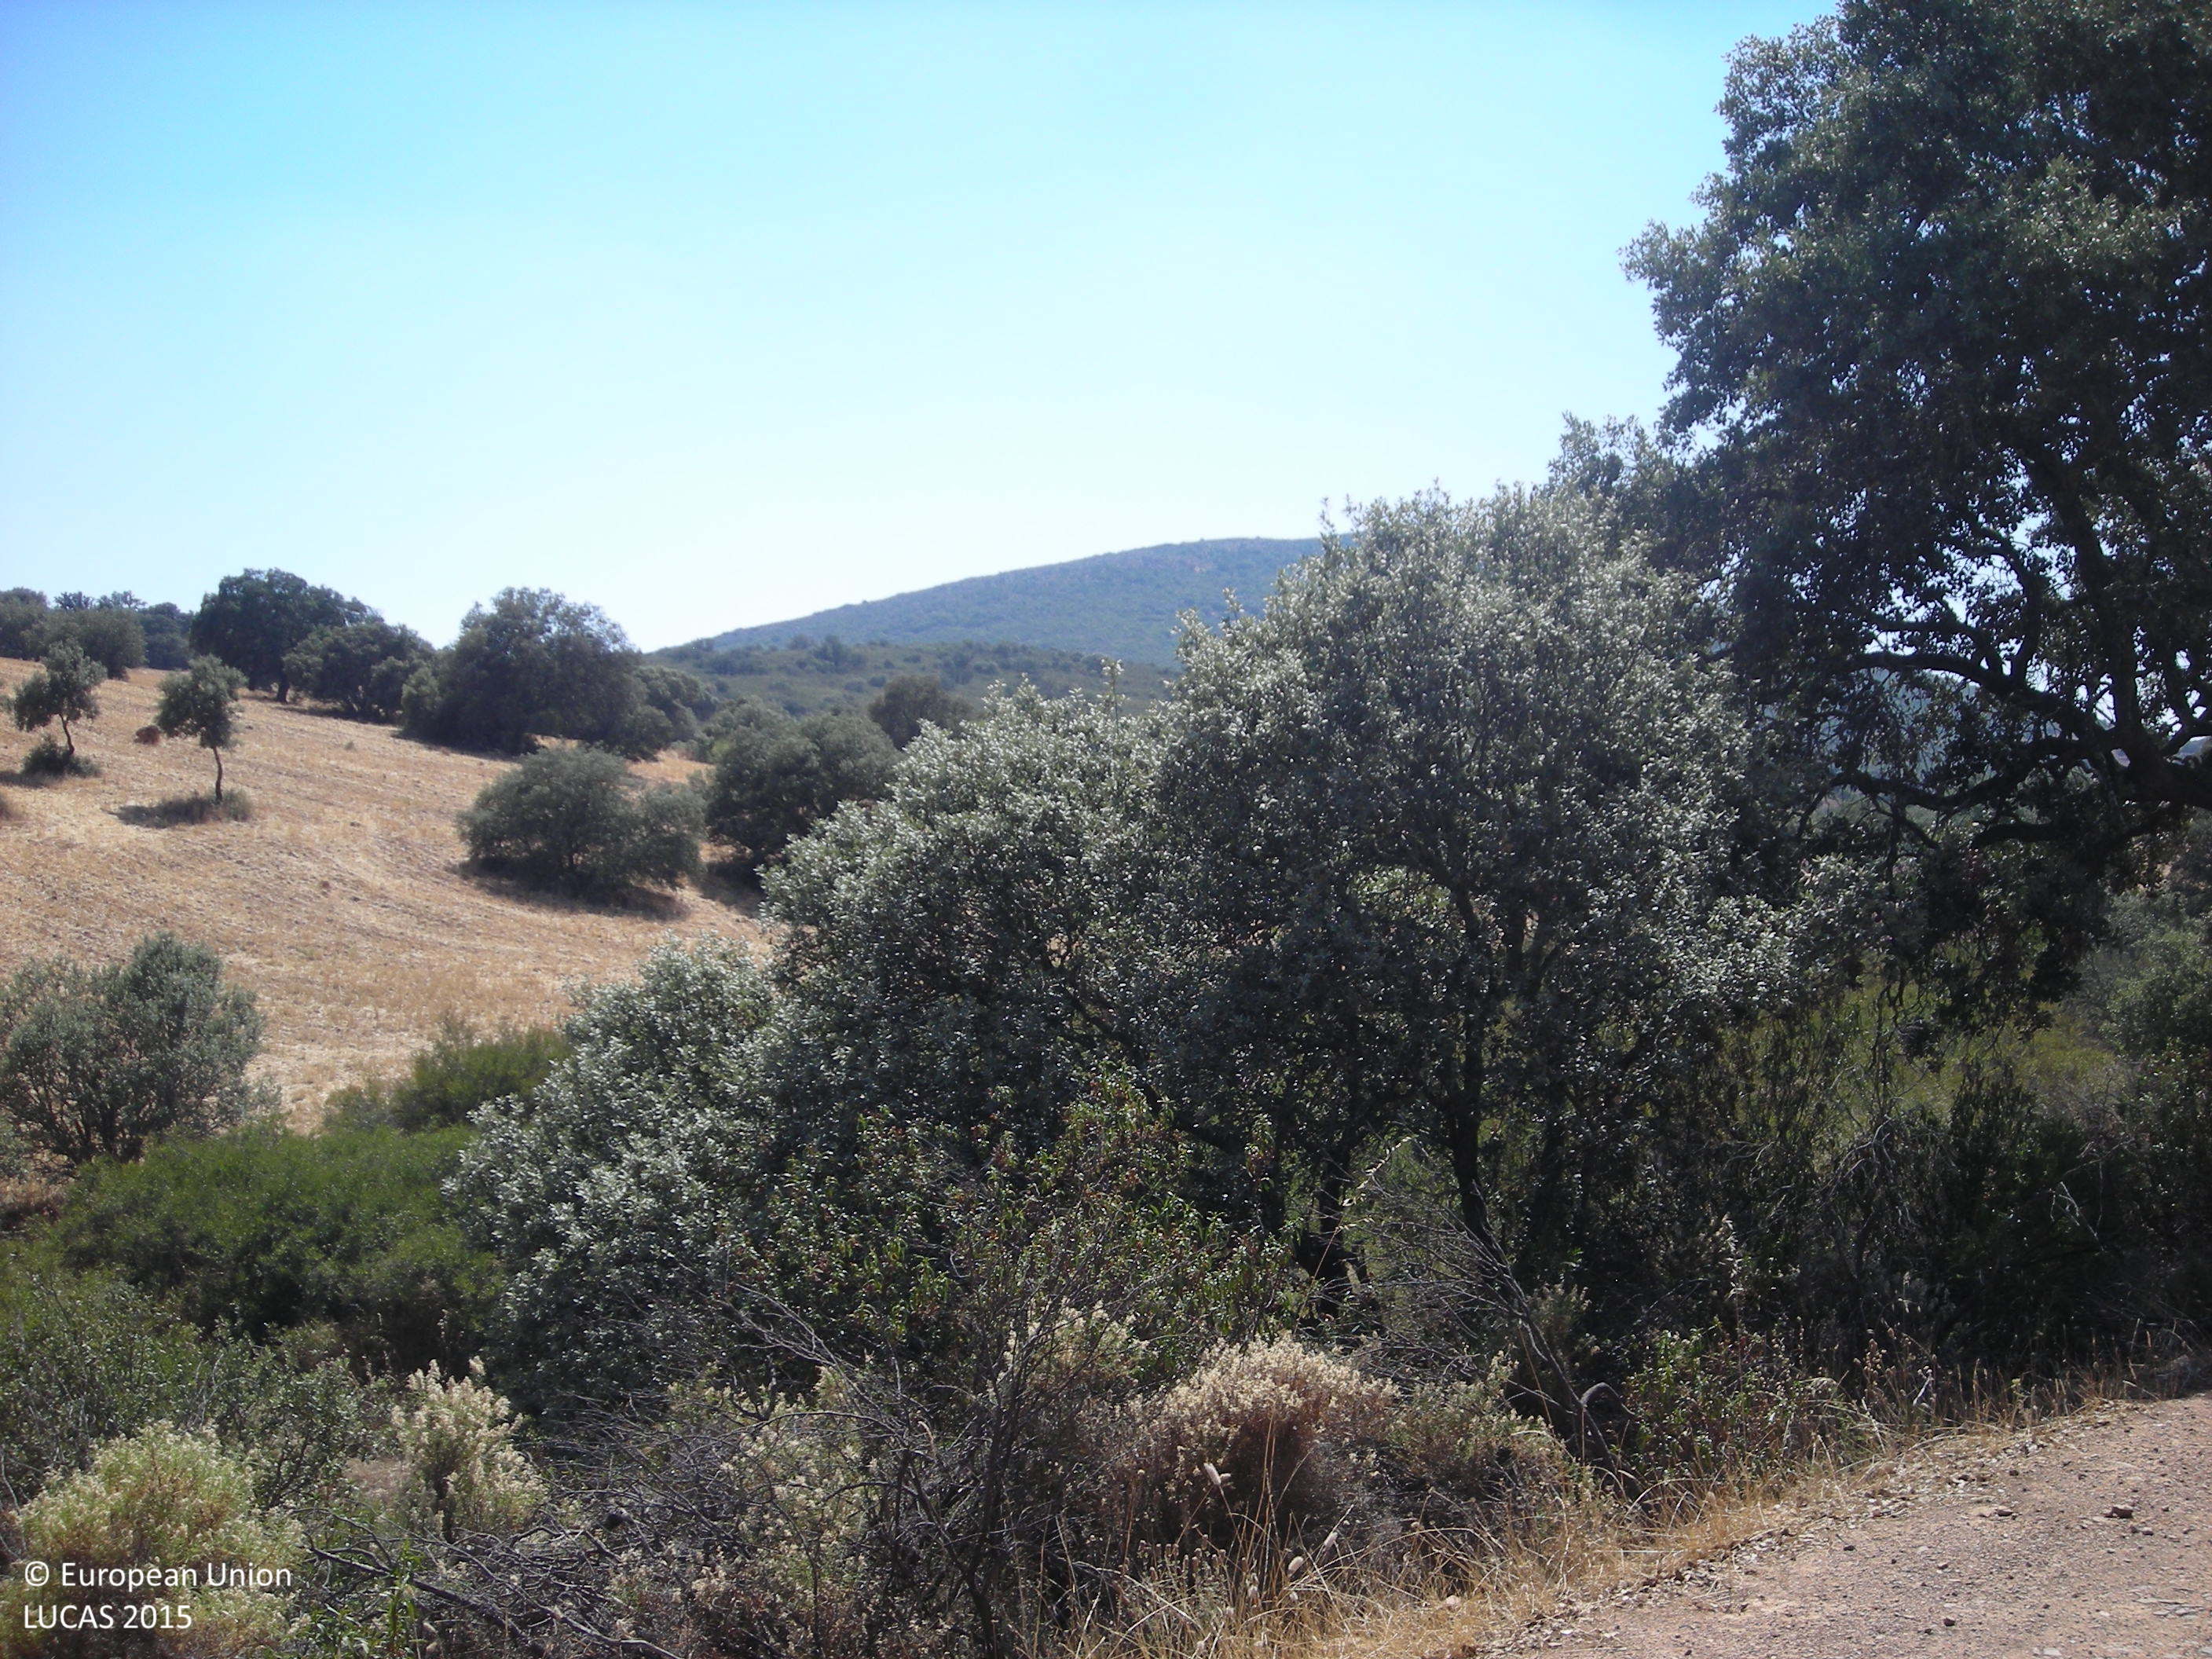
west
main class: Shrubland
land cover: Shrubland with sparse tree cover
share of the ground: > 75 %
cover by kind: shrubs 95 %, broadleaved forest trees 5 %
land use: Semi-natural and natural areas not in use
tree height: > 5 m
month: June
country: ES
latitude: 38.6437
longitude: -5.8180
